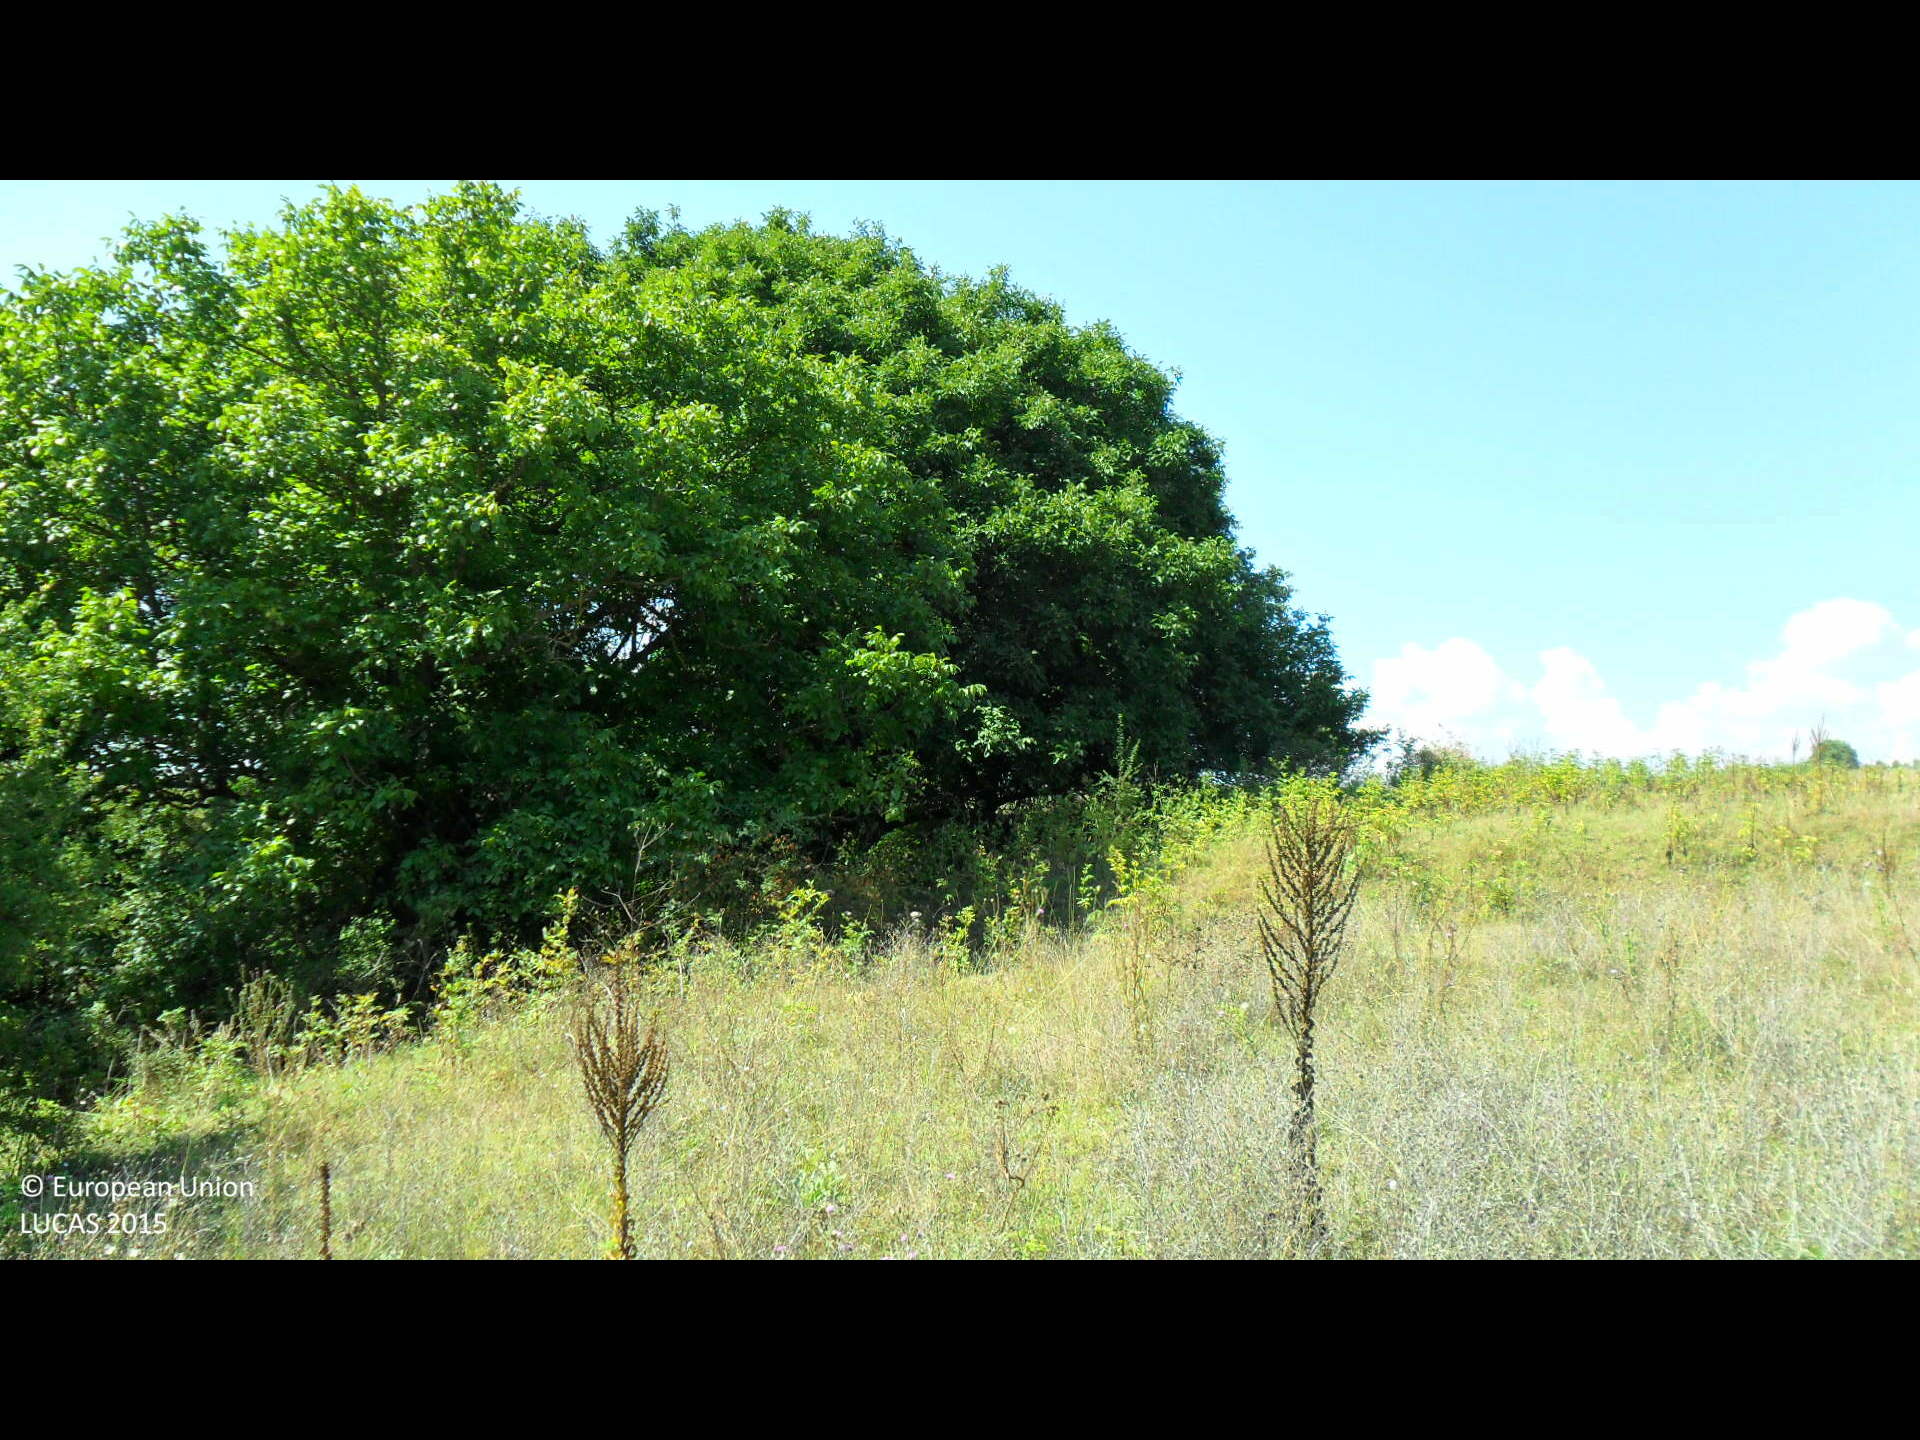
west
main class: Grassland
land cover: Grassland without tree/shrub cover
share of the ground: > 75 %
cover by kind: herbaceous plants 100 %
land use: Agriculture (excluding fallow land and kitchen gardens)
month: August
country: BG
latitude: 43.4377
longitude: 26.2961
